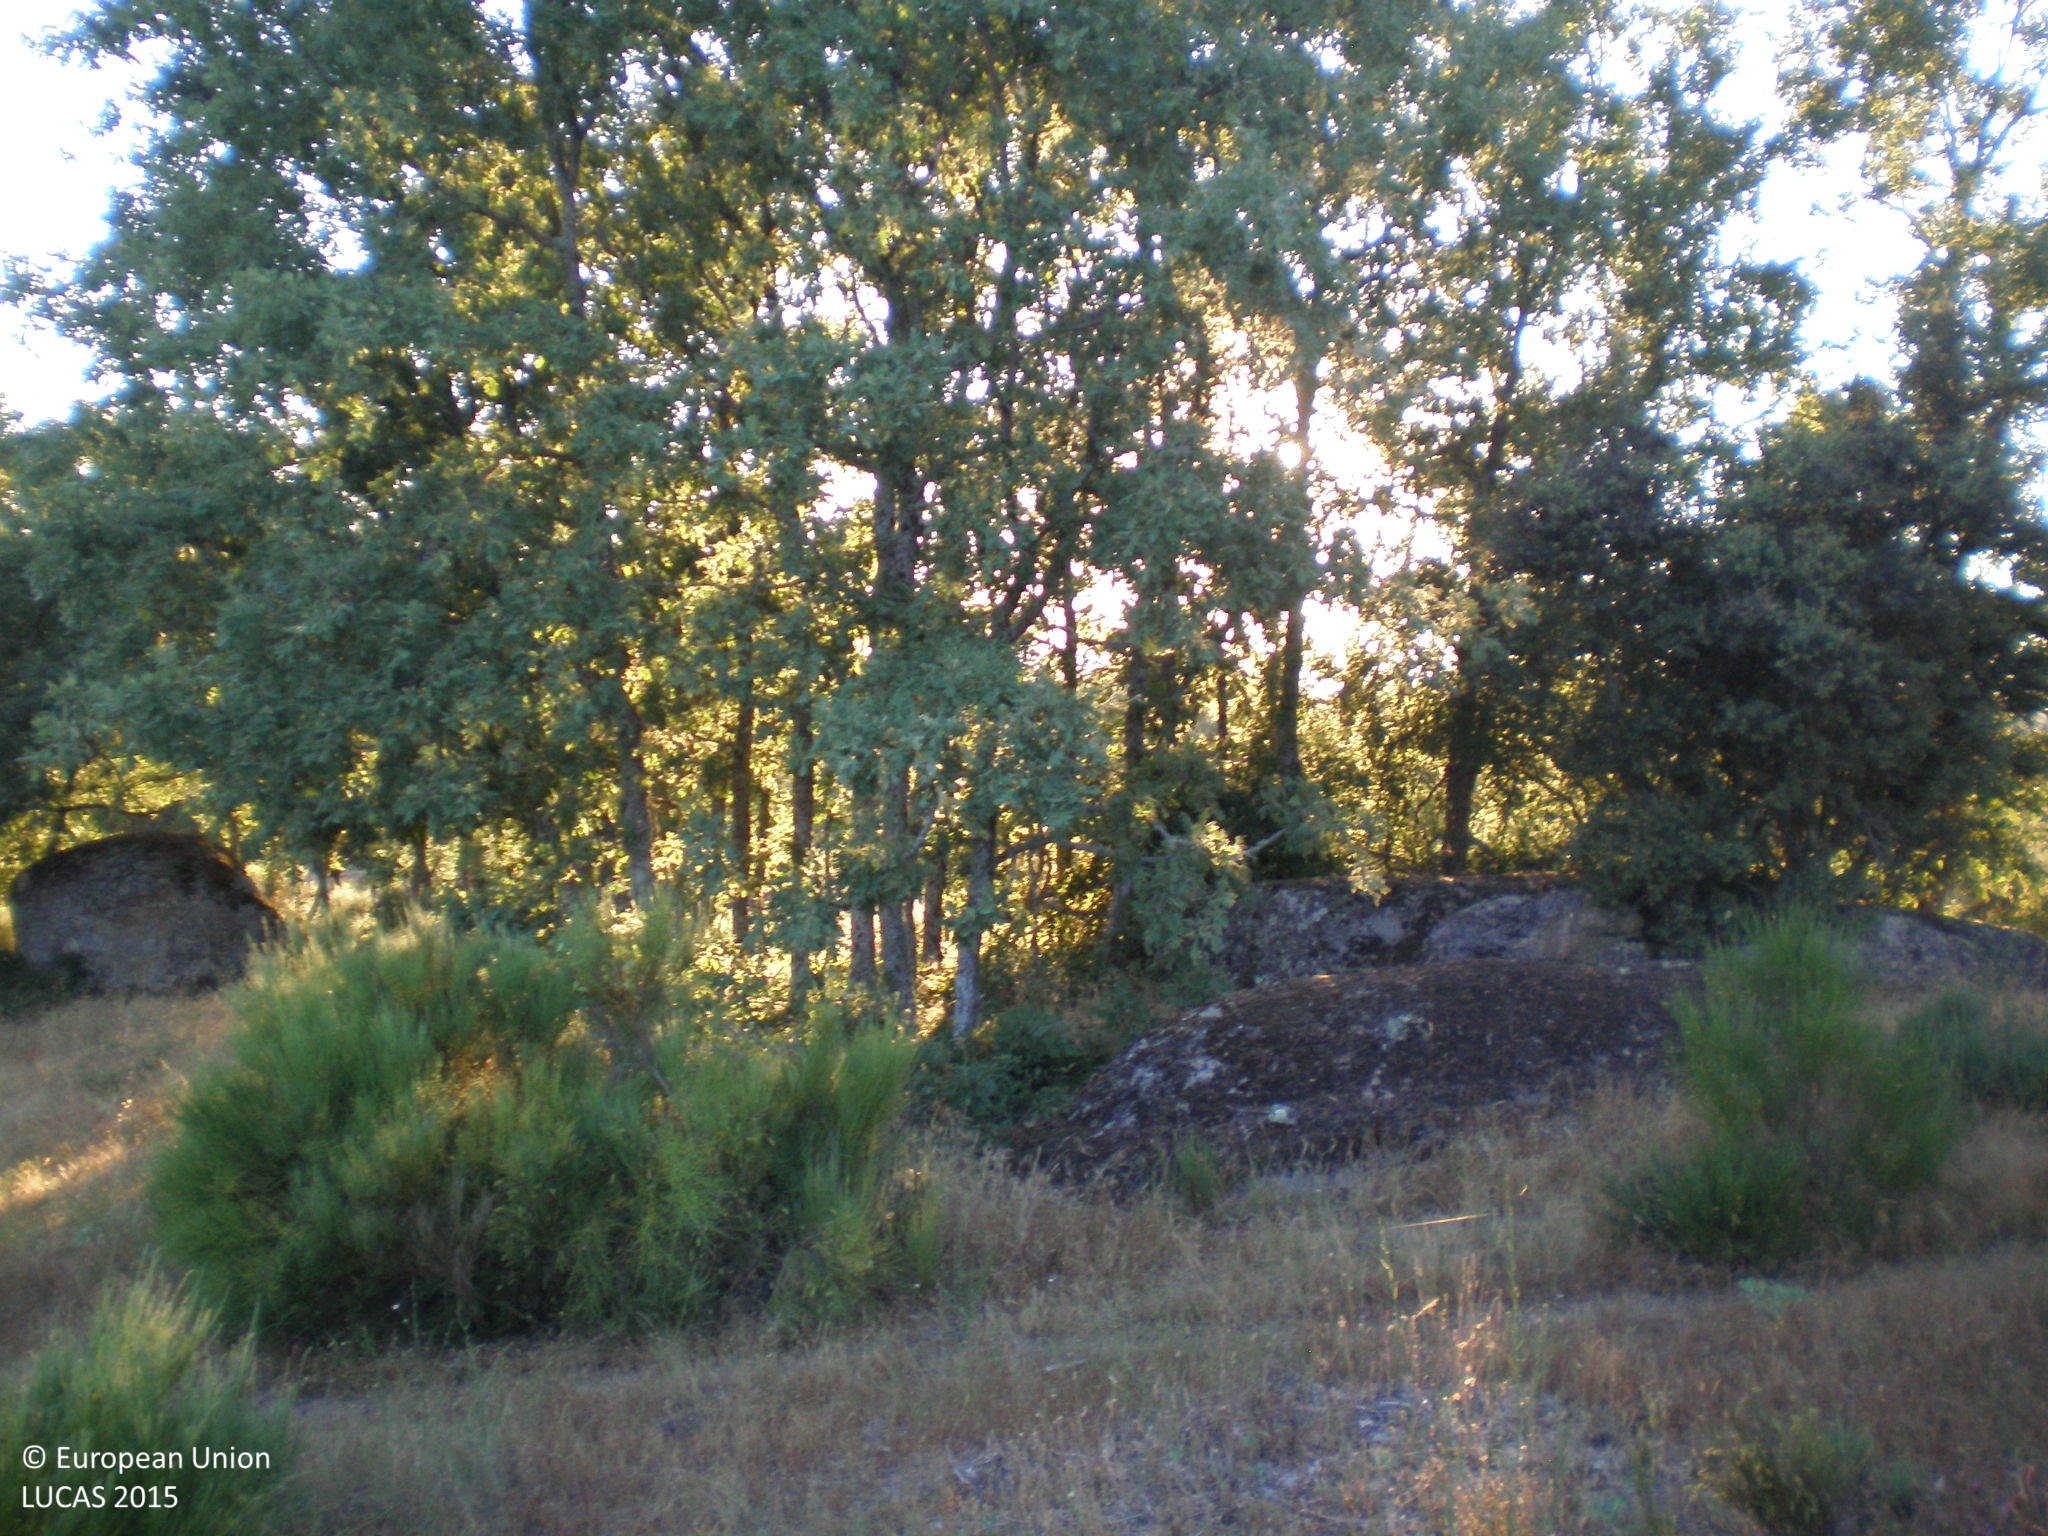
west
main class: Grassland
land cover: Grassland with sparse tree/shrub cover
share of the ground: > 75 %
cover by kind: herbaceous plants 95 %, broadleaved forest trees 5 %
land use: Agriculture (excluding fallow land and kitchen gardens)
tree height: < 5 m
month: June
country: ES
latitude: 40.5391
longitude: -5.8121
